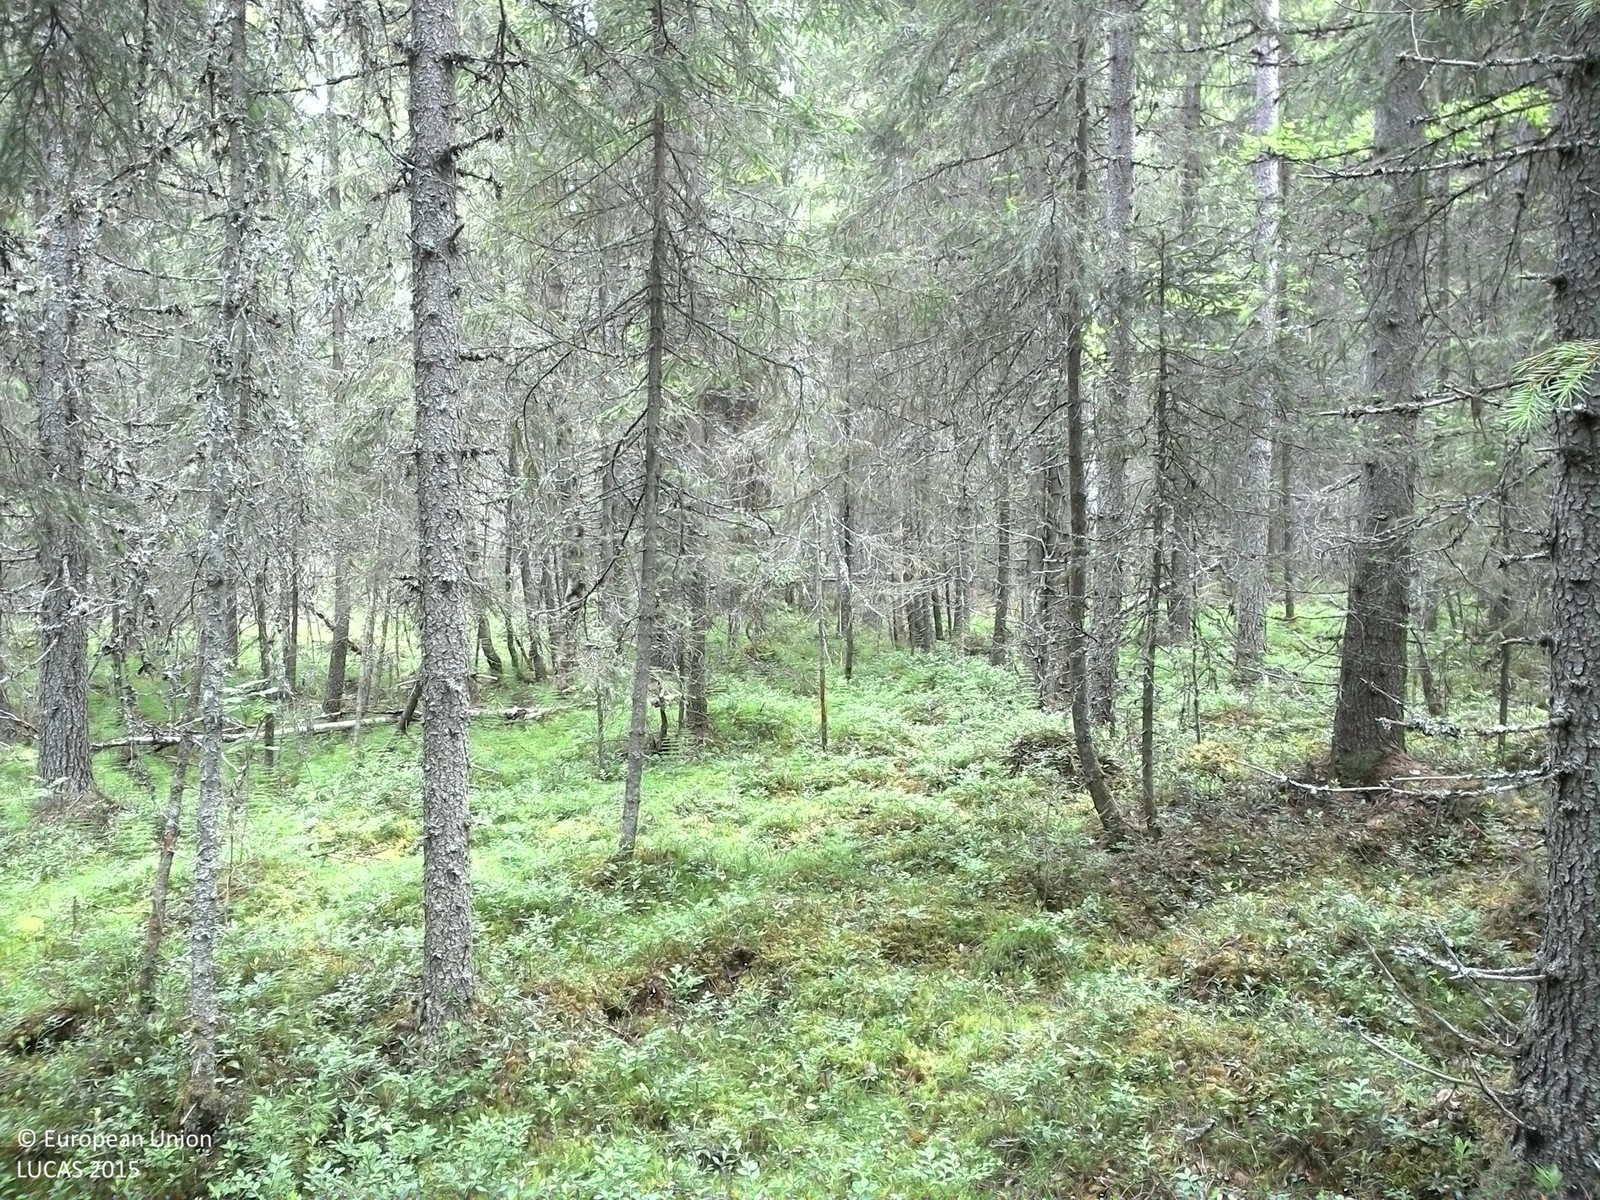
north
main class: Woodland
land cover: Spruce dominated coniferous woodland
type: boreal forest
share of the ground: > 75 %
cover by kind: coniferous forest trees 75 %, shrubs 15 %, broadleaved forest trees 5 %, herbaceous plants 5 %
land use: Forestry
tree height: > 5 m
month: July
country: SE
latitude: 63.5529
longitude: 18.4885
